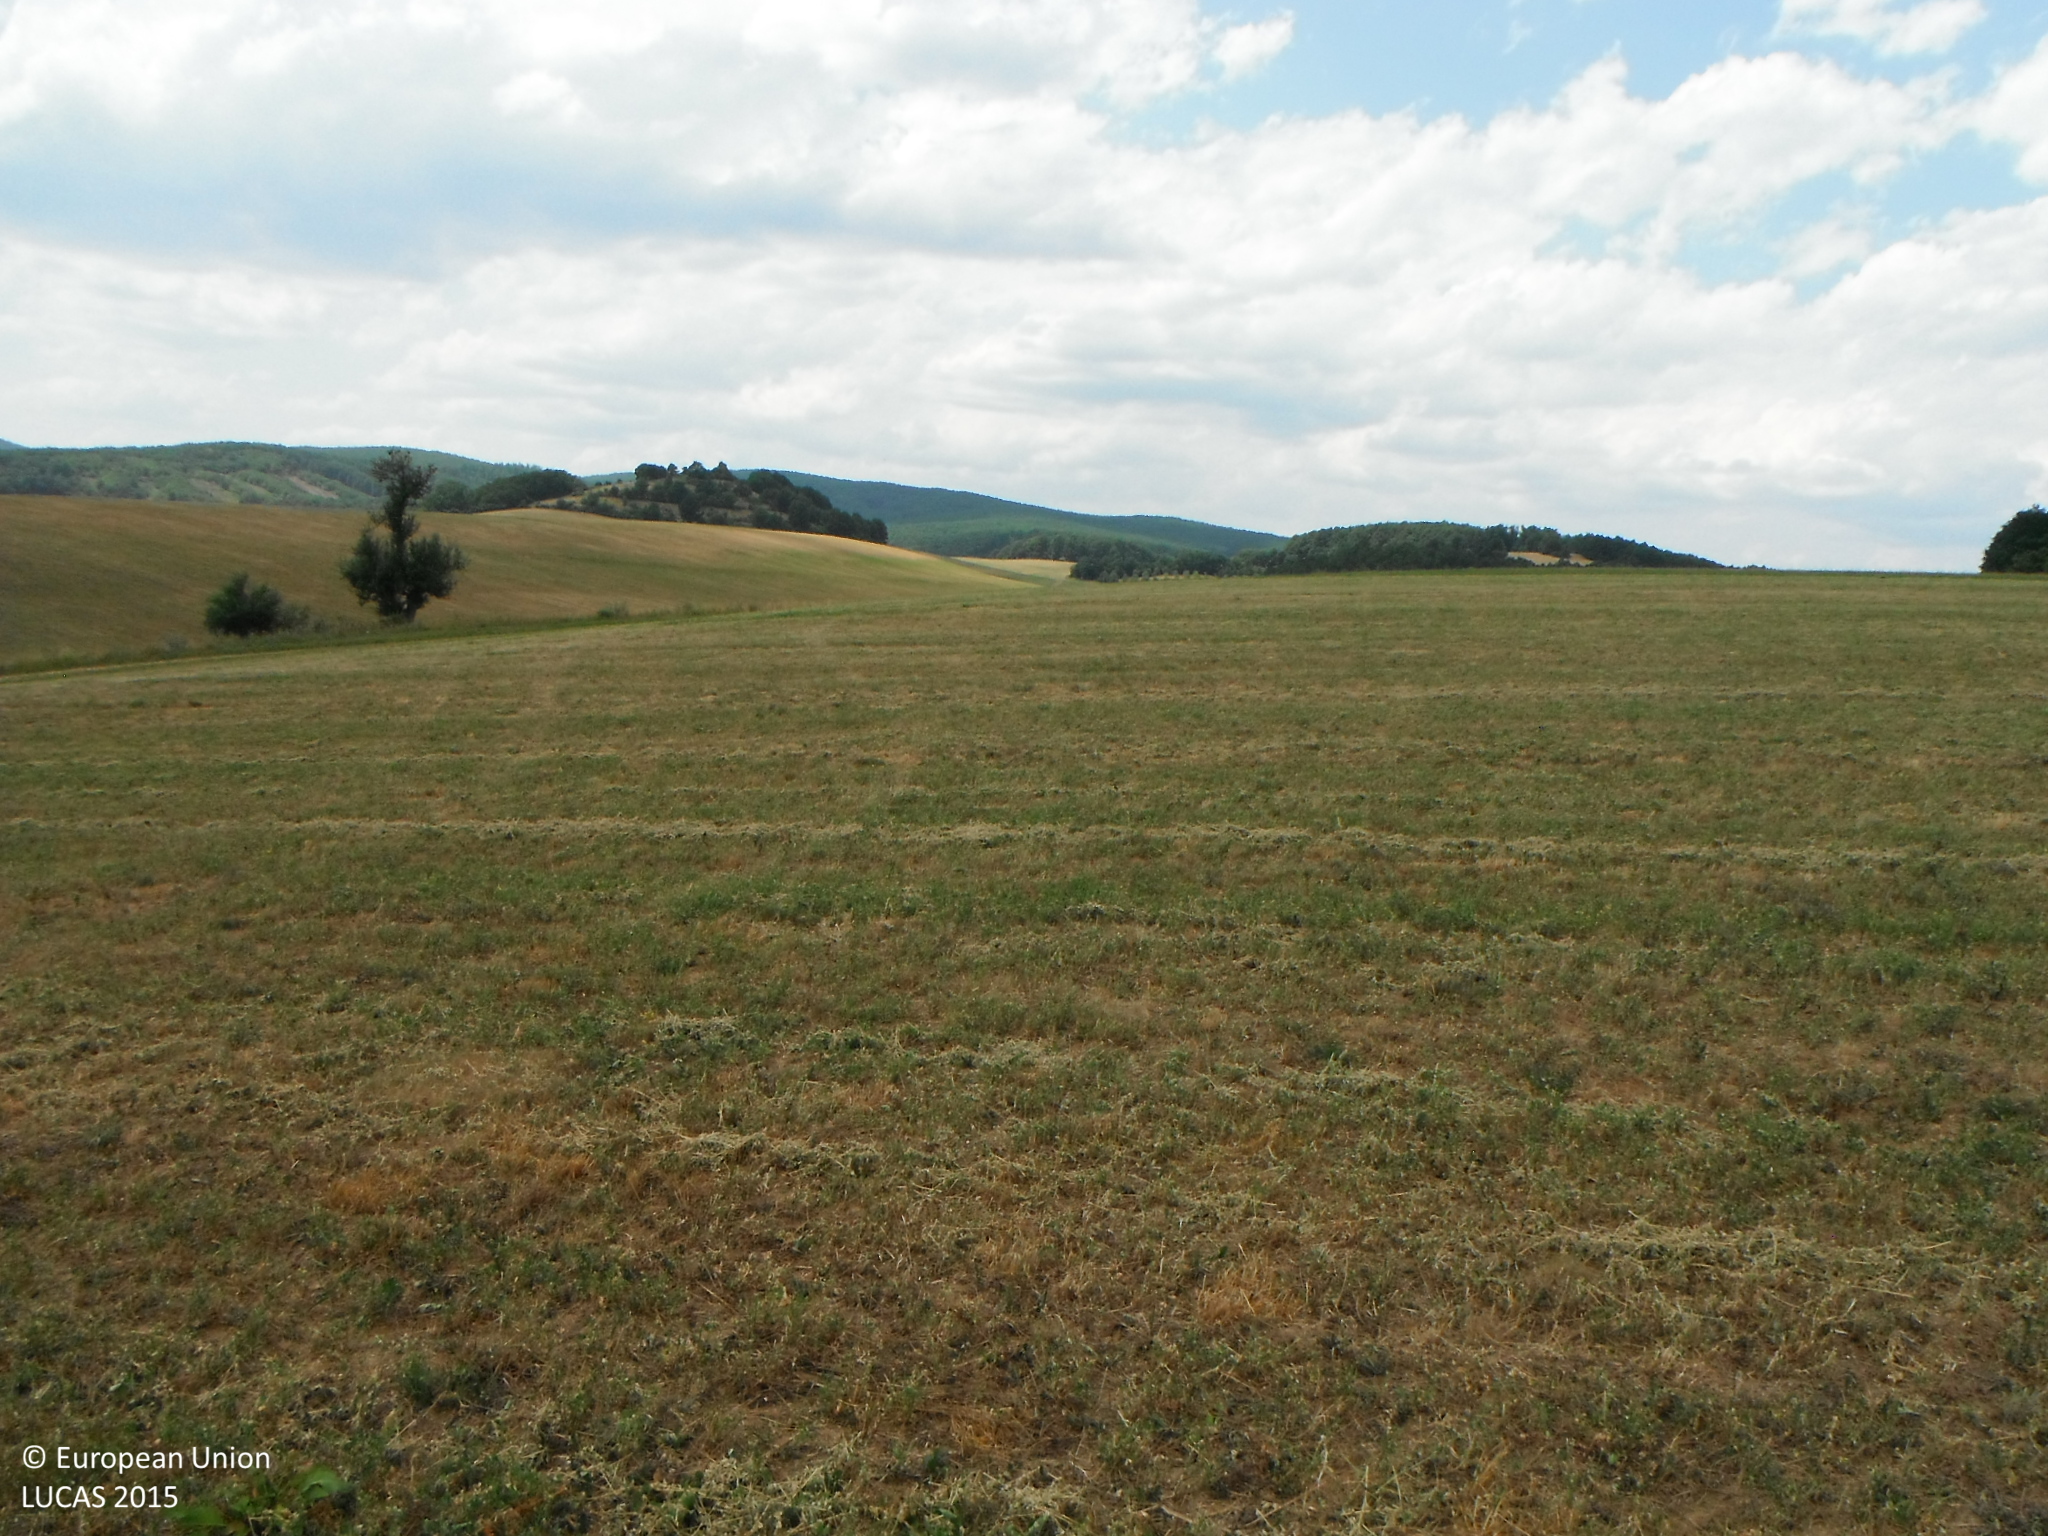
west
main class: Cropland
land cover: Lucerne
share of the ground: > 75 %
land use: Agriculture (excluding fallow land and kitchen gardens)
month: July
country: SK
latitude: 48.4446
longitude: 19.0924
